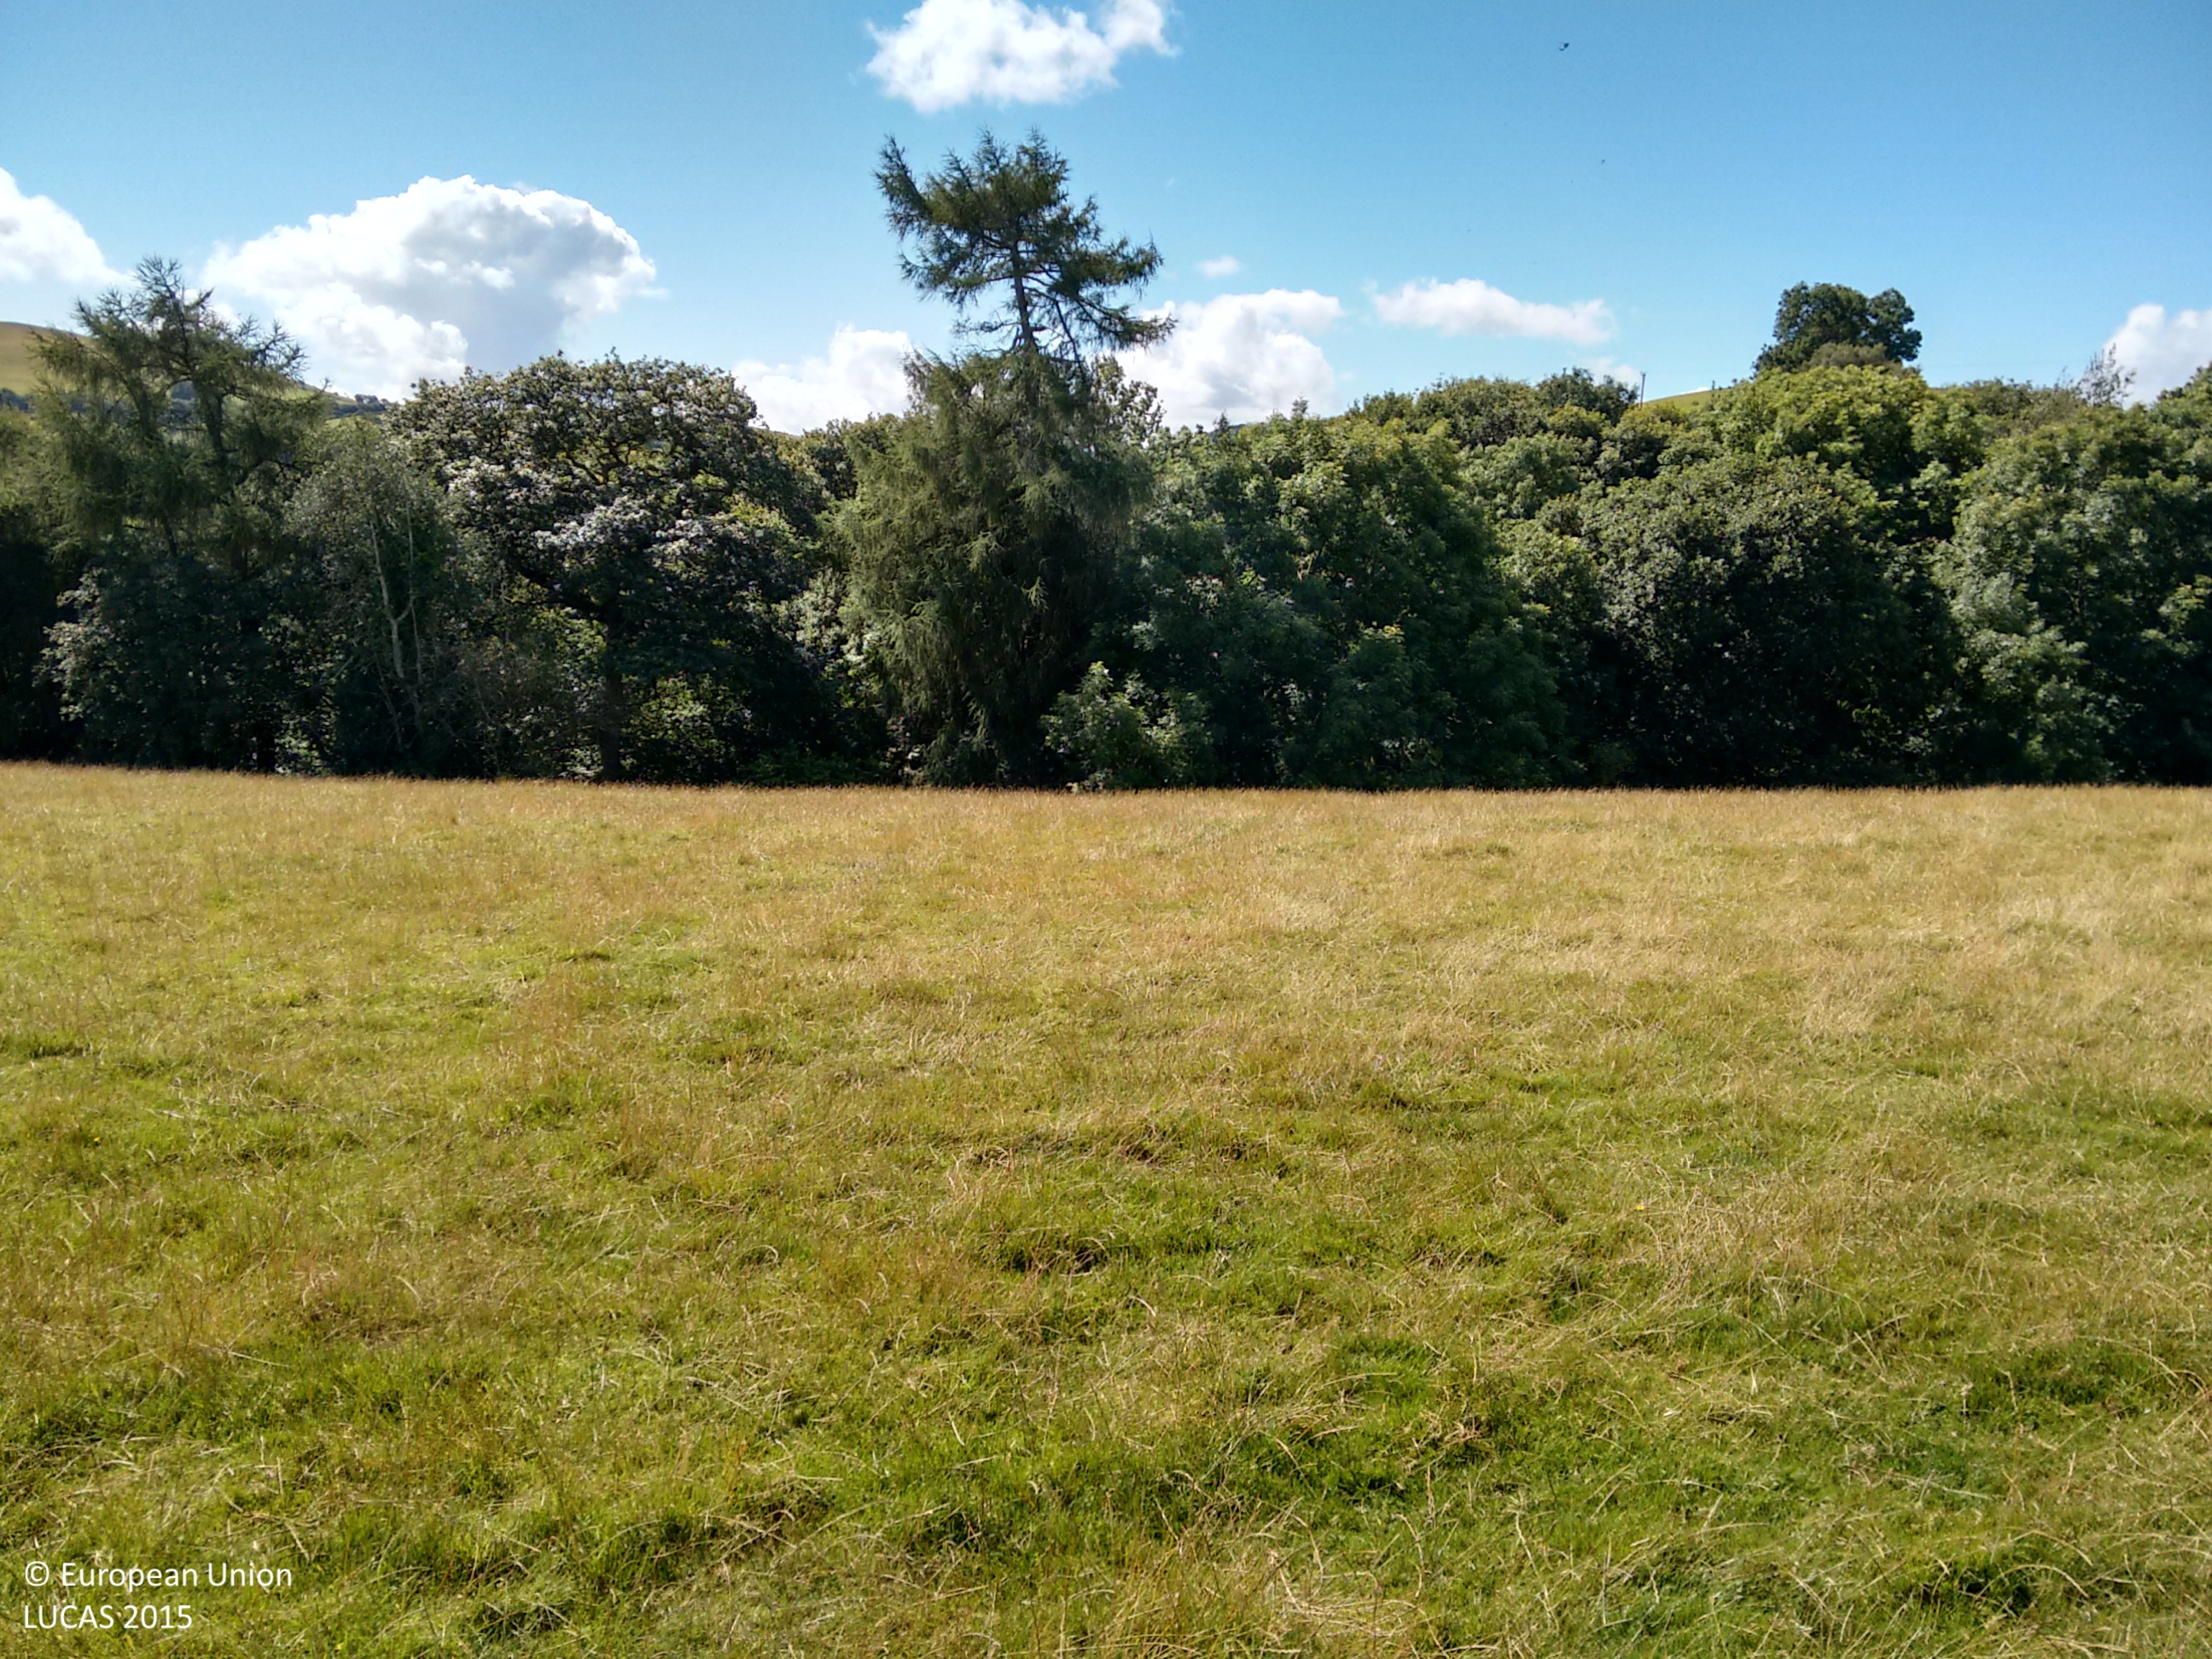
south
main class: Grassland
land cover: Grassland without tree/shrub cover
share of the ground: > 75 %
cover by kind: herbaceous plants 100 %
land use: Agriculture (excluding fallow land and kitchen gardens)
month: August
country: GB
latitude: 53.1701
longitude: -3.5027
